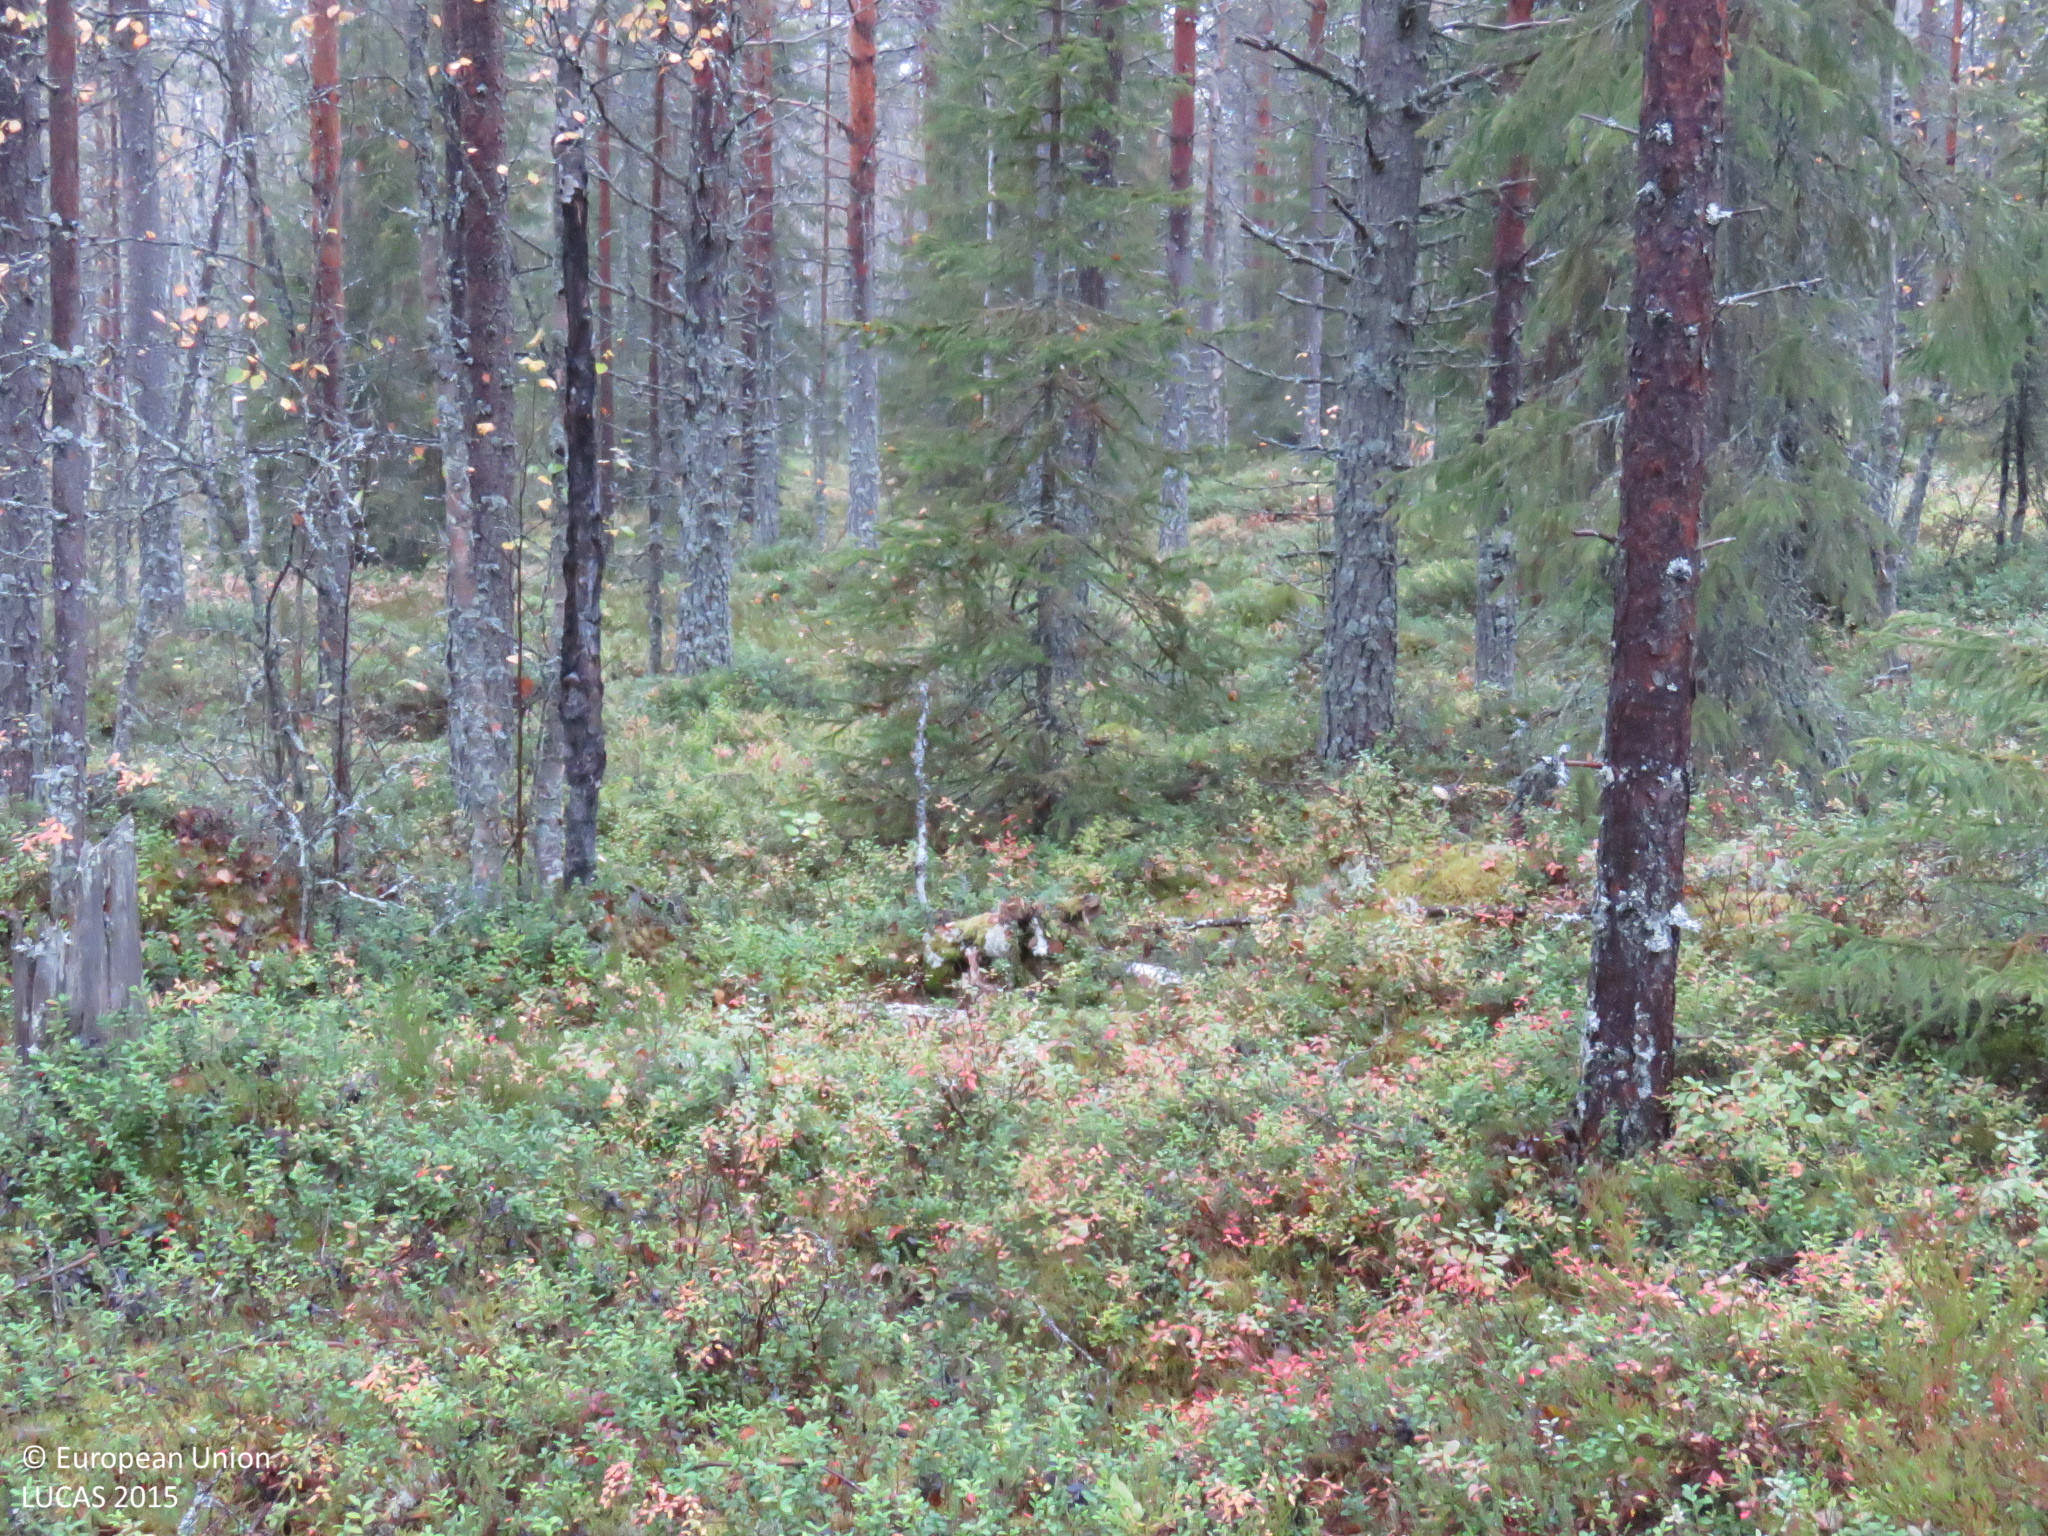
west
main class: Woodland
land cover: Pine dominated coniferous woodland
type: boreal forest
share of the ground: > 75 %
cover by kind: coniferous forest trees 65 %, shrubs 15 %, broadleaved forest trees 10 %, lichens and mosses 10 %
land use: Forestry
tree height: > 5 m
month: September
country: FI
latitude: 64.8221
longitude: 26.8684
